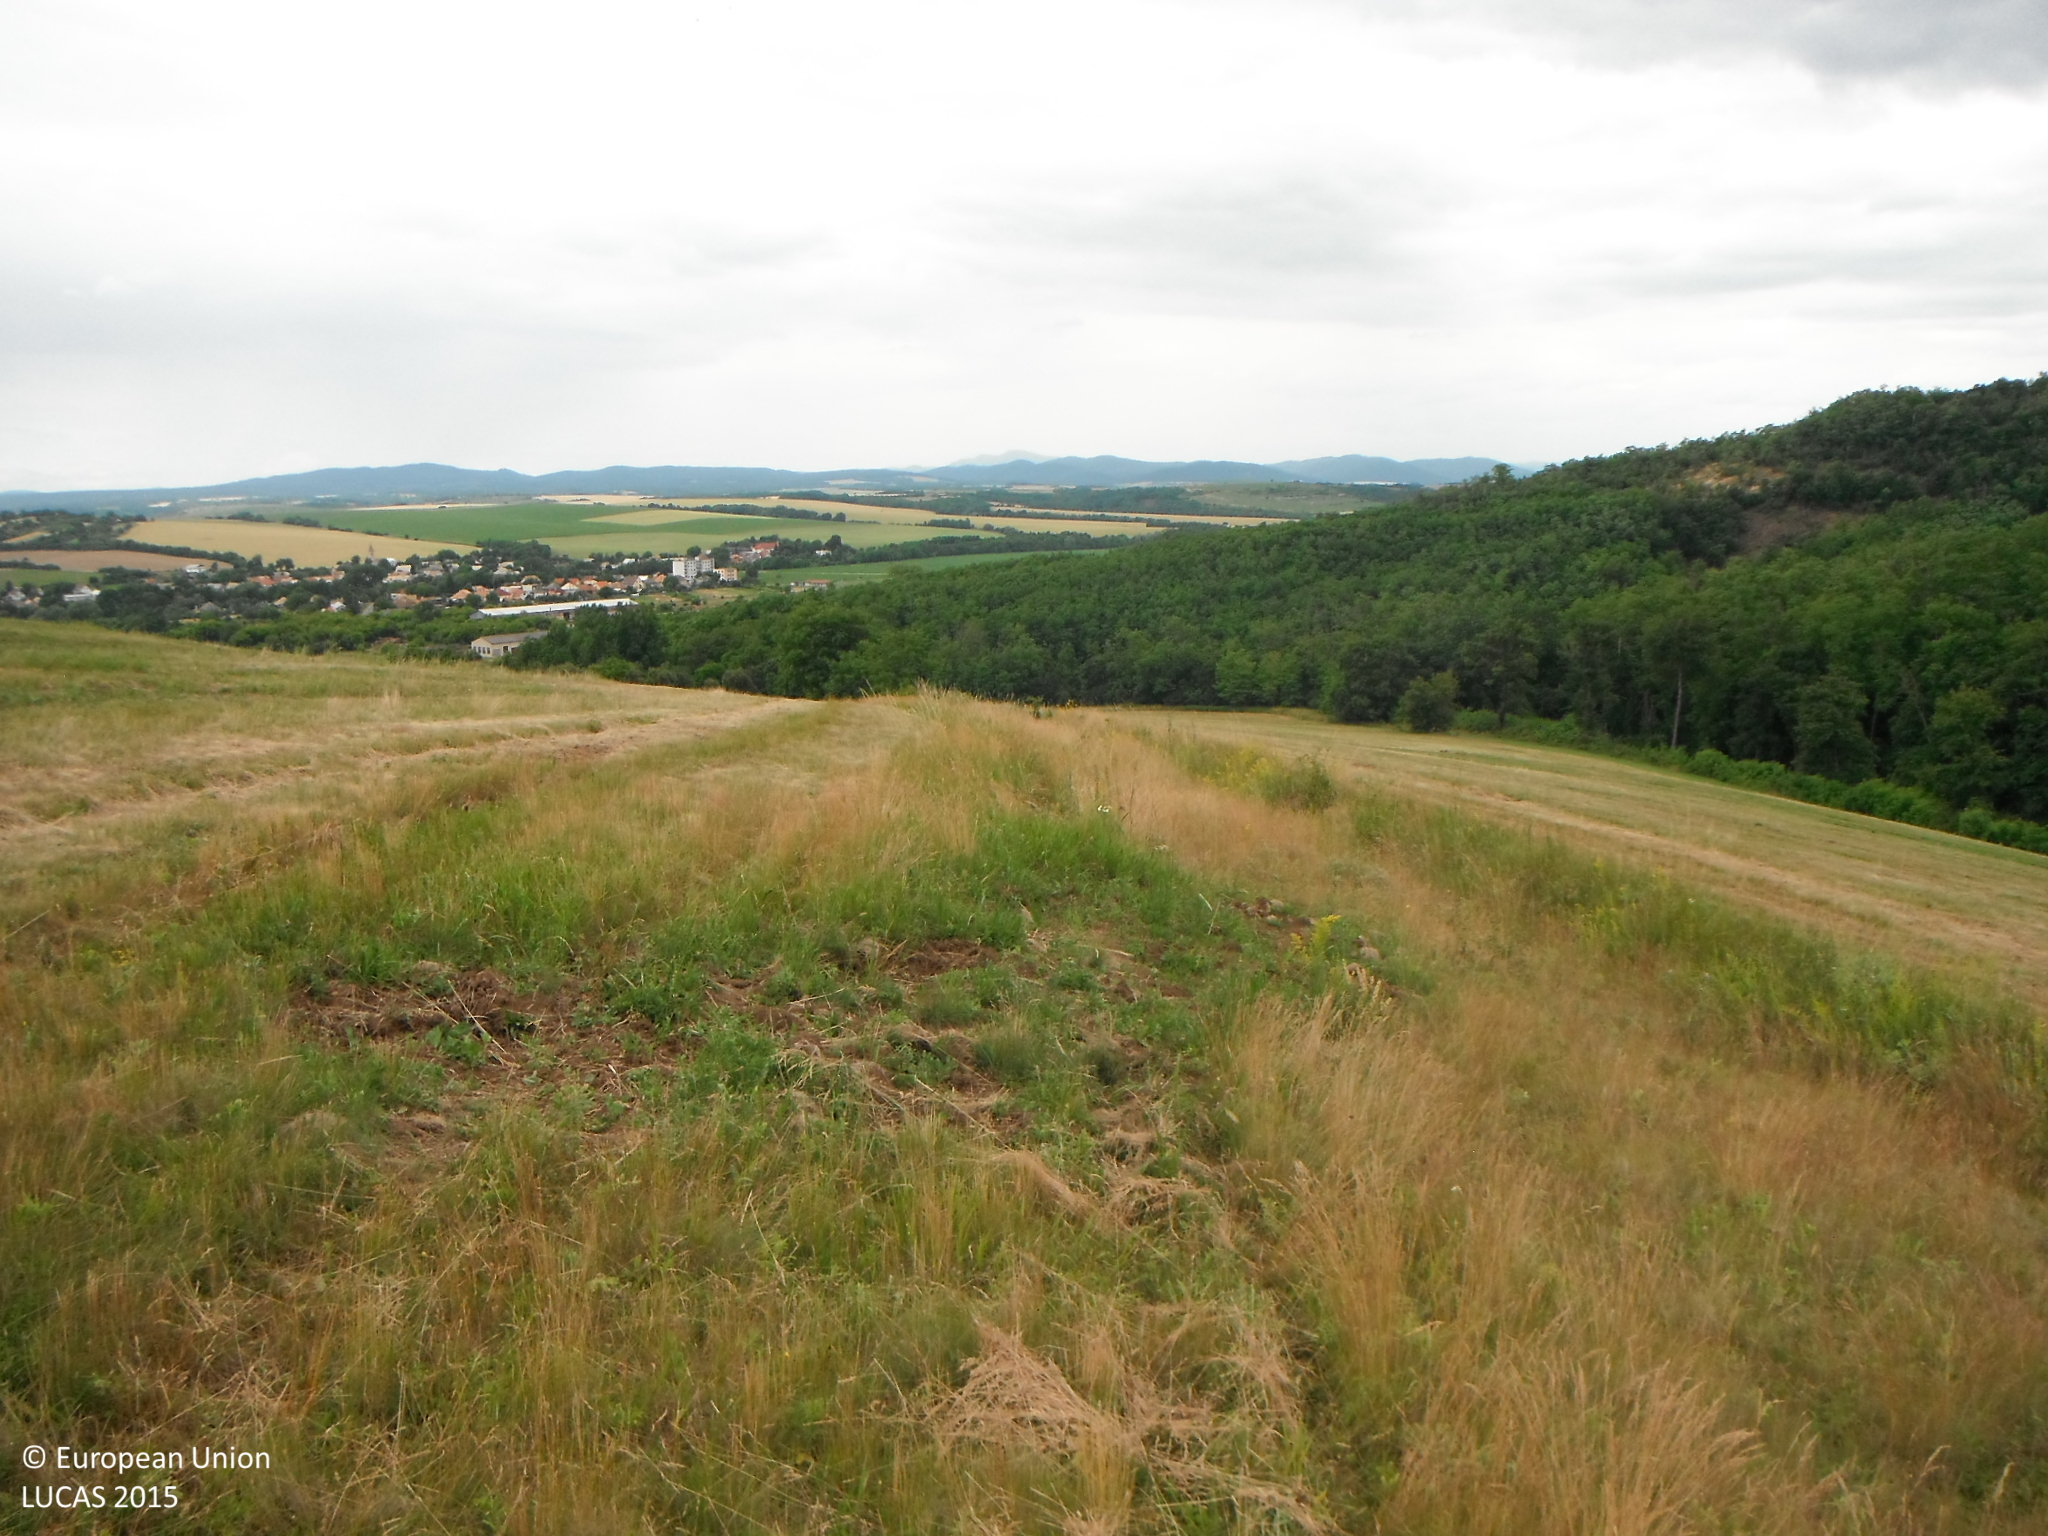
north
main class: Grassland
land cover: Grassland without tree/shrub cover
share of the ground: > 75 %
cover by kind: herbaceous plants 100 %
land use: Agriculture (excluding fallow land and kitchen gardens)
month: June
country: SK
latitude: 48.1701
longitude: 18.9073
